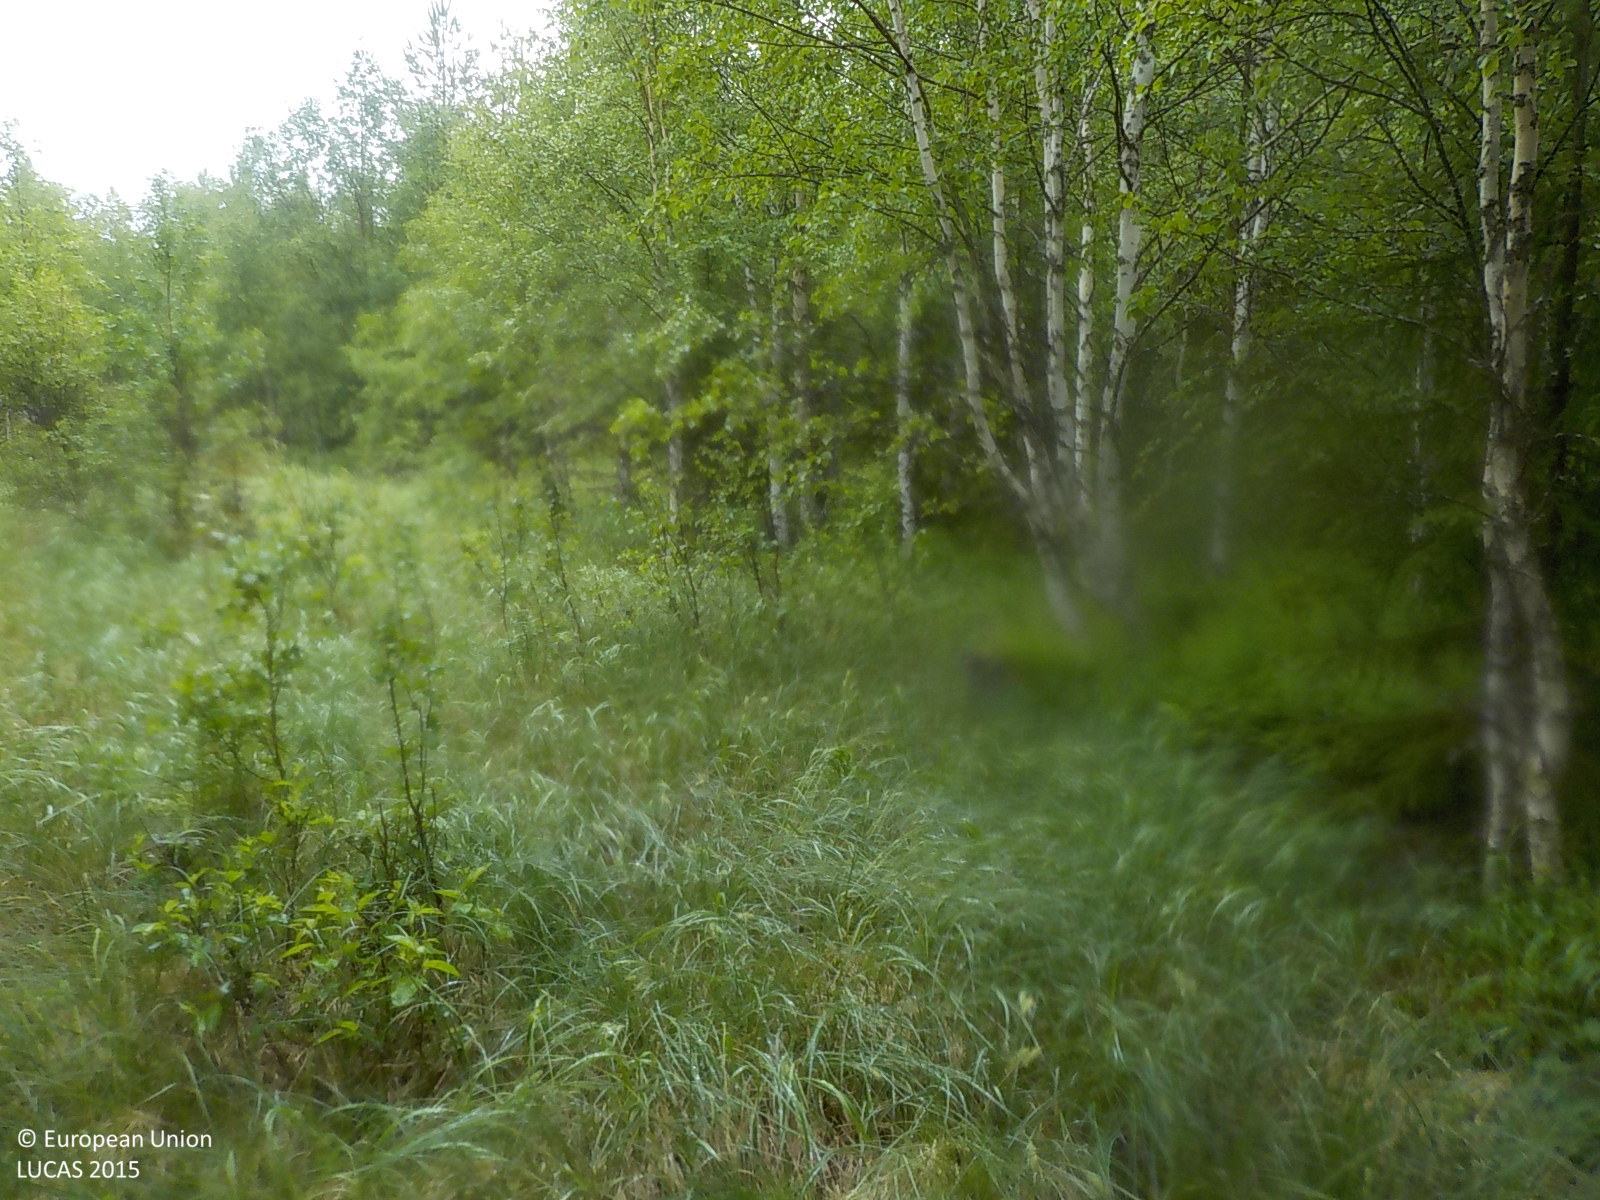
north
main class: Woodland
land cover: Broadleaved woodland
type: boreal forest
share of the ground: 50 - 75 %
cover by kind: broadleaved forest trees 60 %, herbaceous plants 30 %, lichens and mosses 10 %
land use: Forestry
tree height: > 5 m
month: July
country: SE
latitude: 63.1012
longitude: 17.0094
